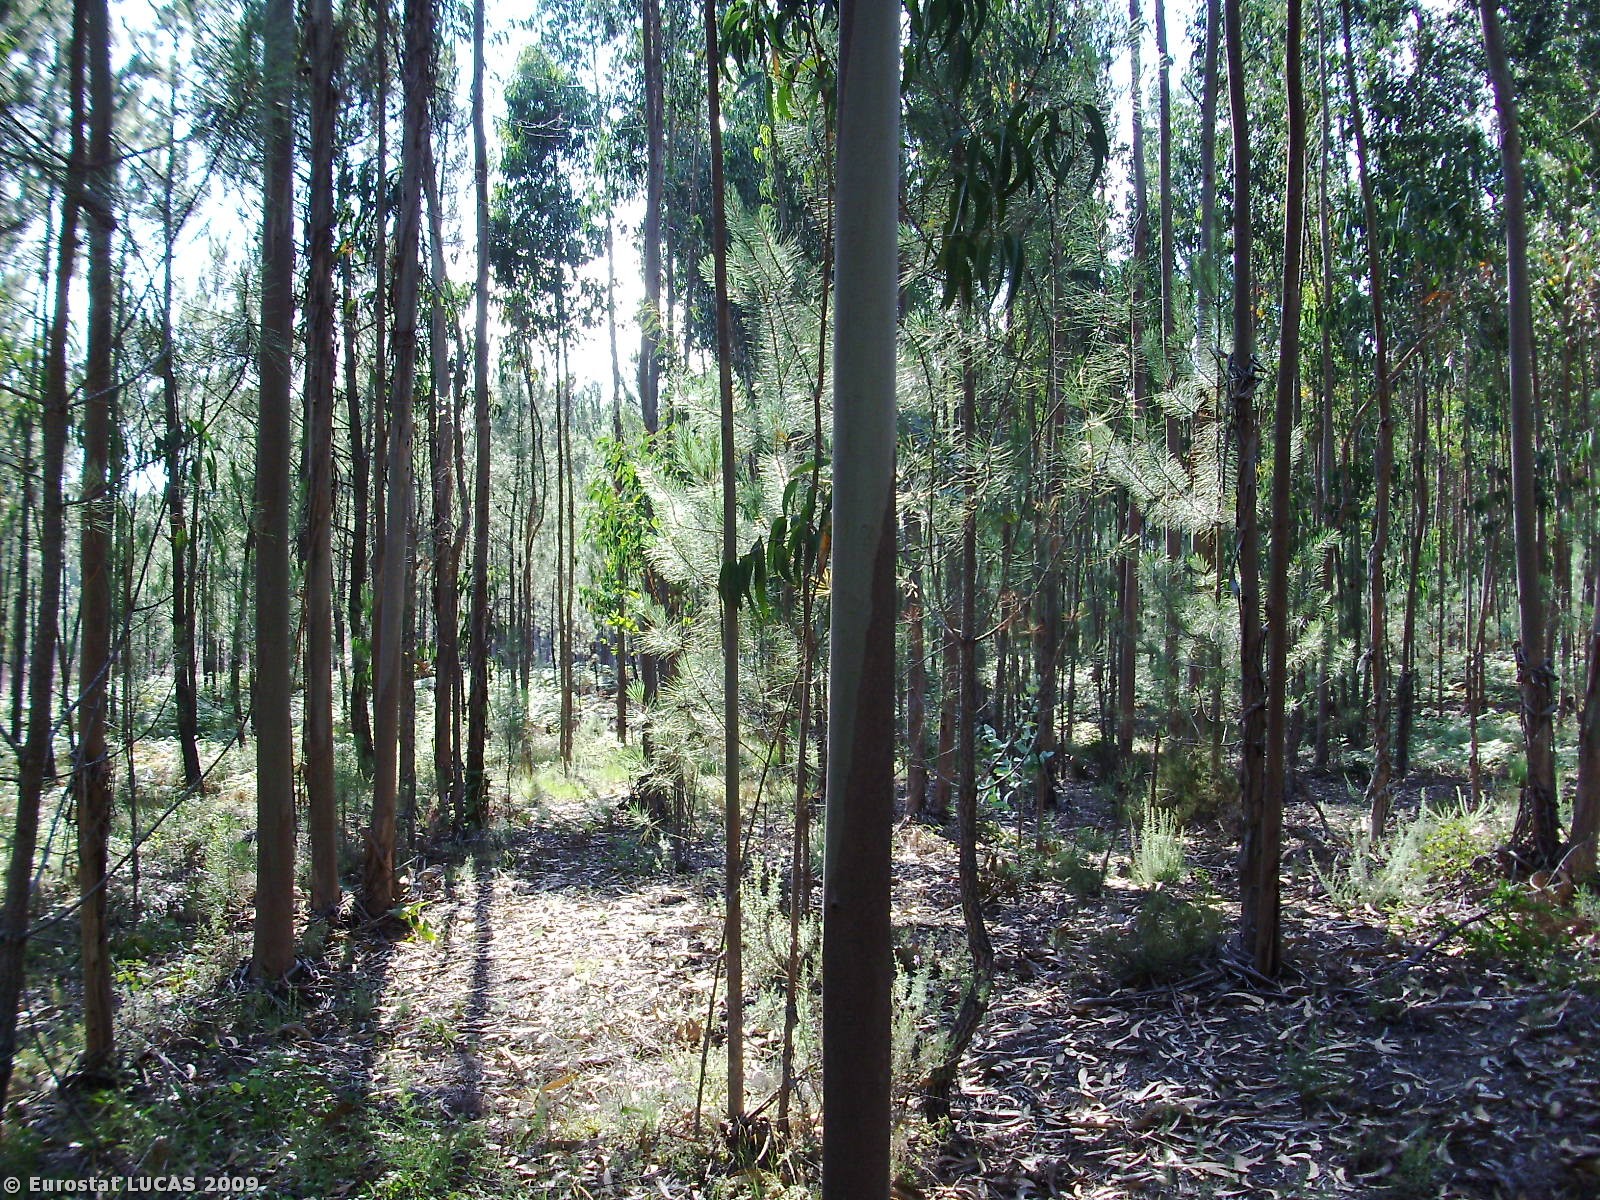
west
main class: Woodland
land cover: Broadleaved woodland
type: plantations and self-sown exotic forest
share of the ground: 50 - 75 %
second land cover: Spontaneously vegetated surfaces
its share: 25 - 50 %
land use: Forestry
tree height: > 5 m
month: July
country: PT
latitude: 39.6460
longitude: -8.9311
